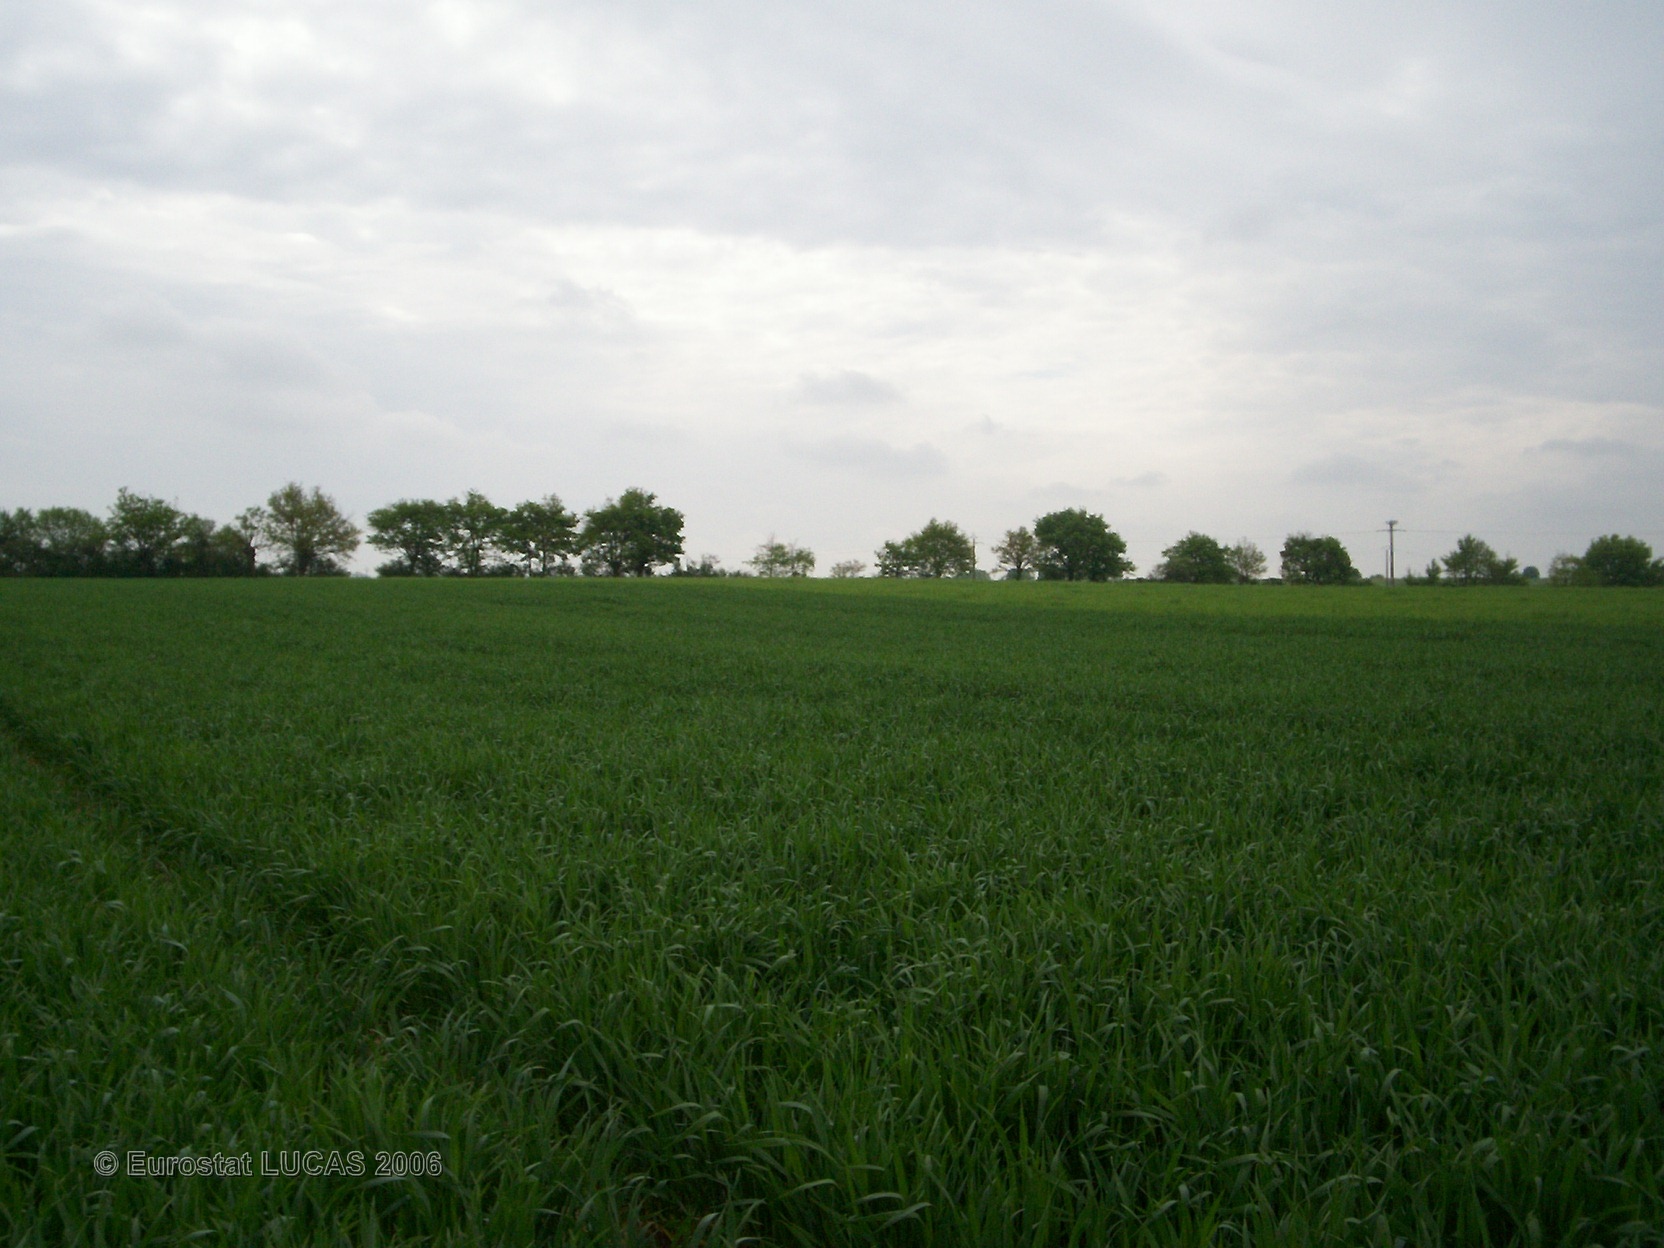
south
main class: Cropland
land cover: Common wheat
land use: Agriculture (excluding fallow land and kitchen gardens)
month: May
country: FR
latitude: 46.7942
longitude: -1.0519
